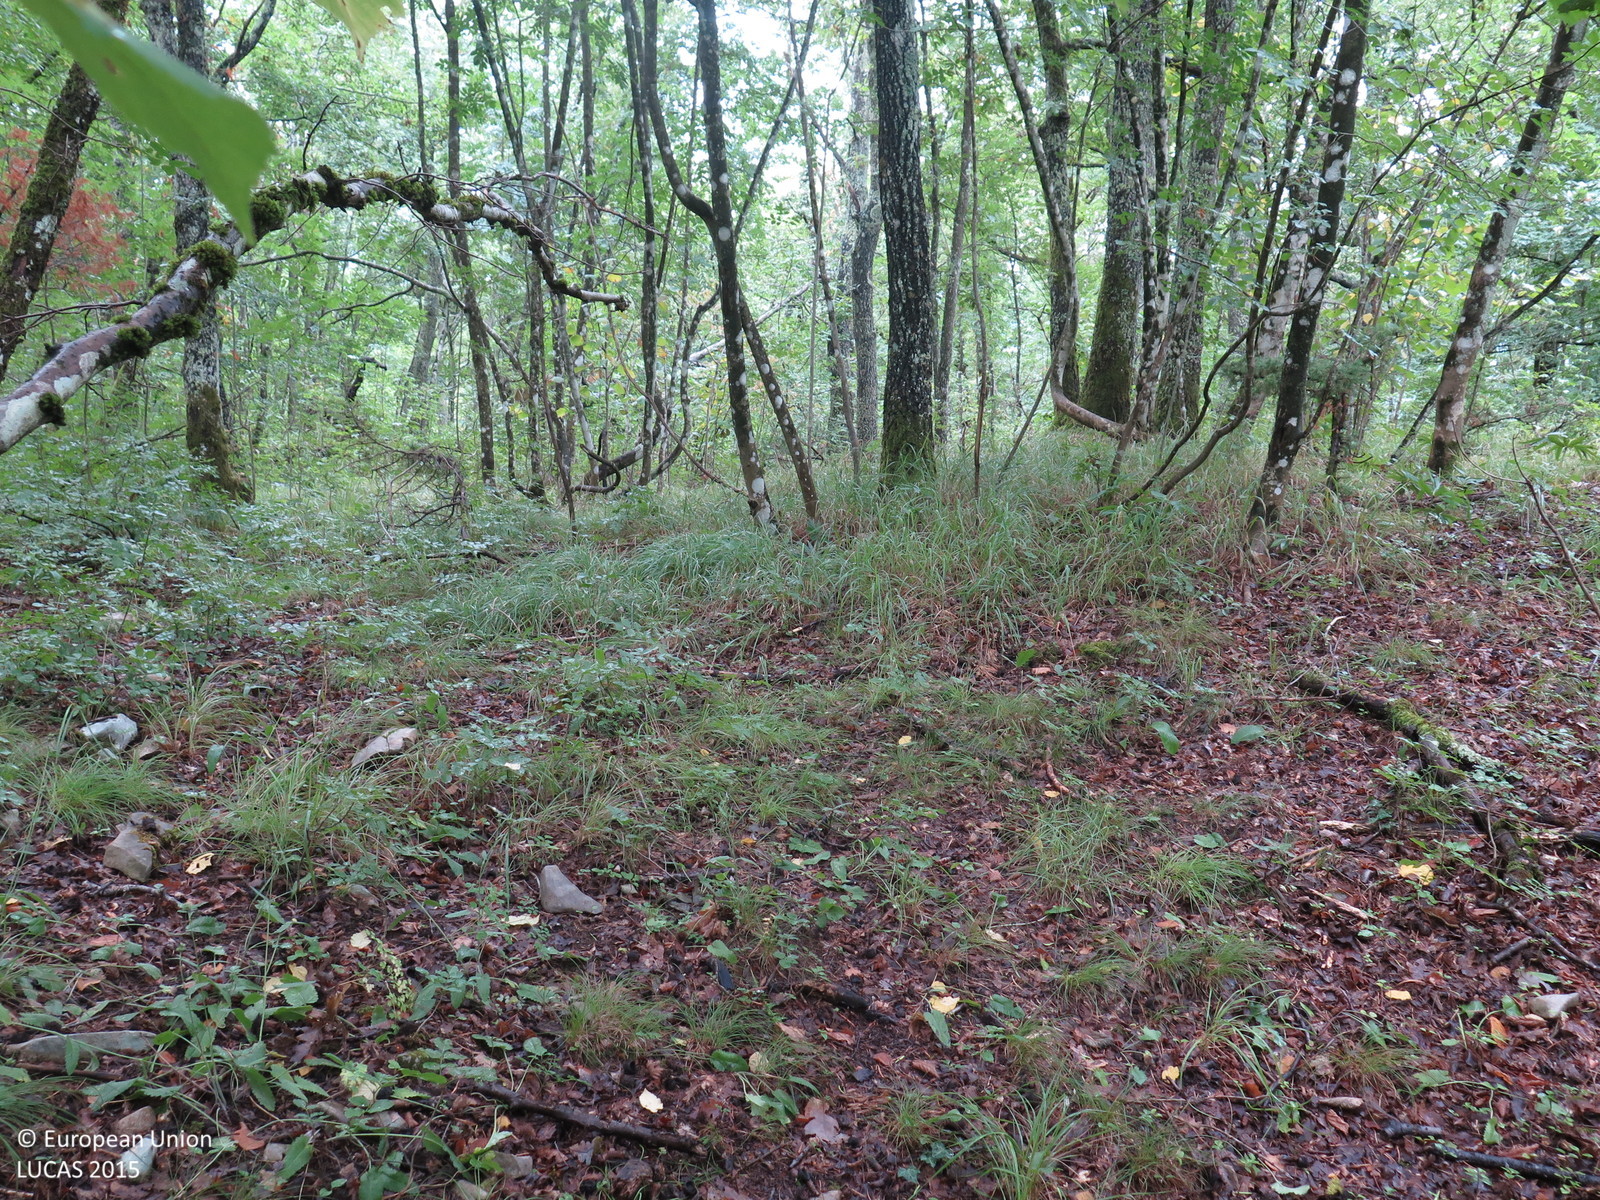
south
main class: Woodland
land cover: Broadleaved woodland
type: beech forest
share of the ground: > 75 %
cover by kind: broadleaved forest trees 95 %, herbaceous plants 5 %
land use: Semi-natural and natural areas not in use
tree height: > 5 m
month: August
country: HR
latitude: 45.4898
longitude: 14.2817
